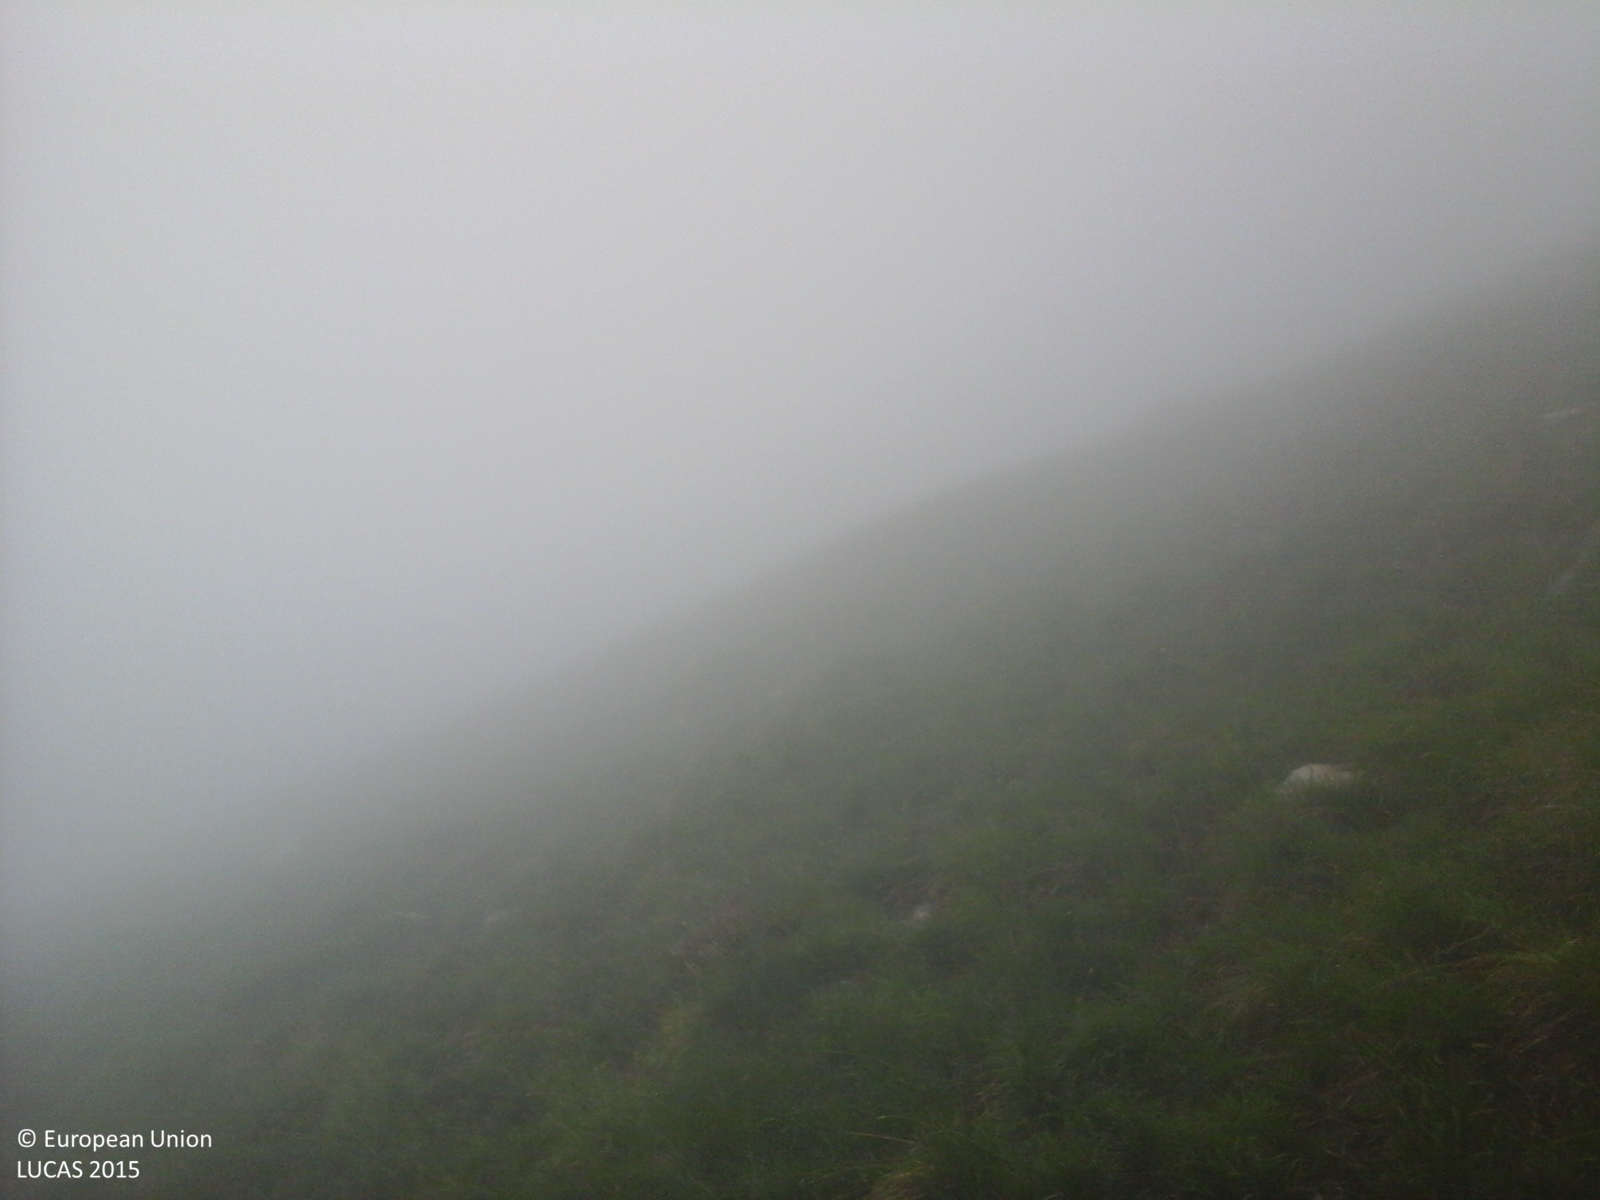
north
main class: Grassland
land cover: Grassland without tree/shrub cover
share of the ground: > 75 %
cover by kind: herbaceous plants 100 %
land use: Agriculture (excluding fallow land and kitchen gardens)
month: May
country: IT
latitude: 45.7712
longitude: 10.8602
